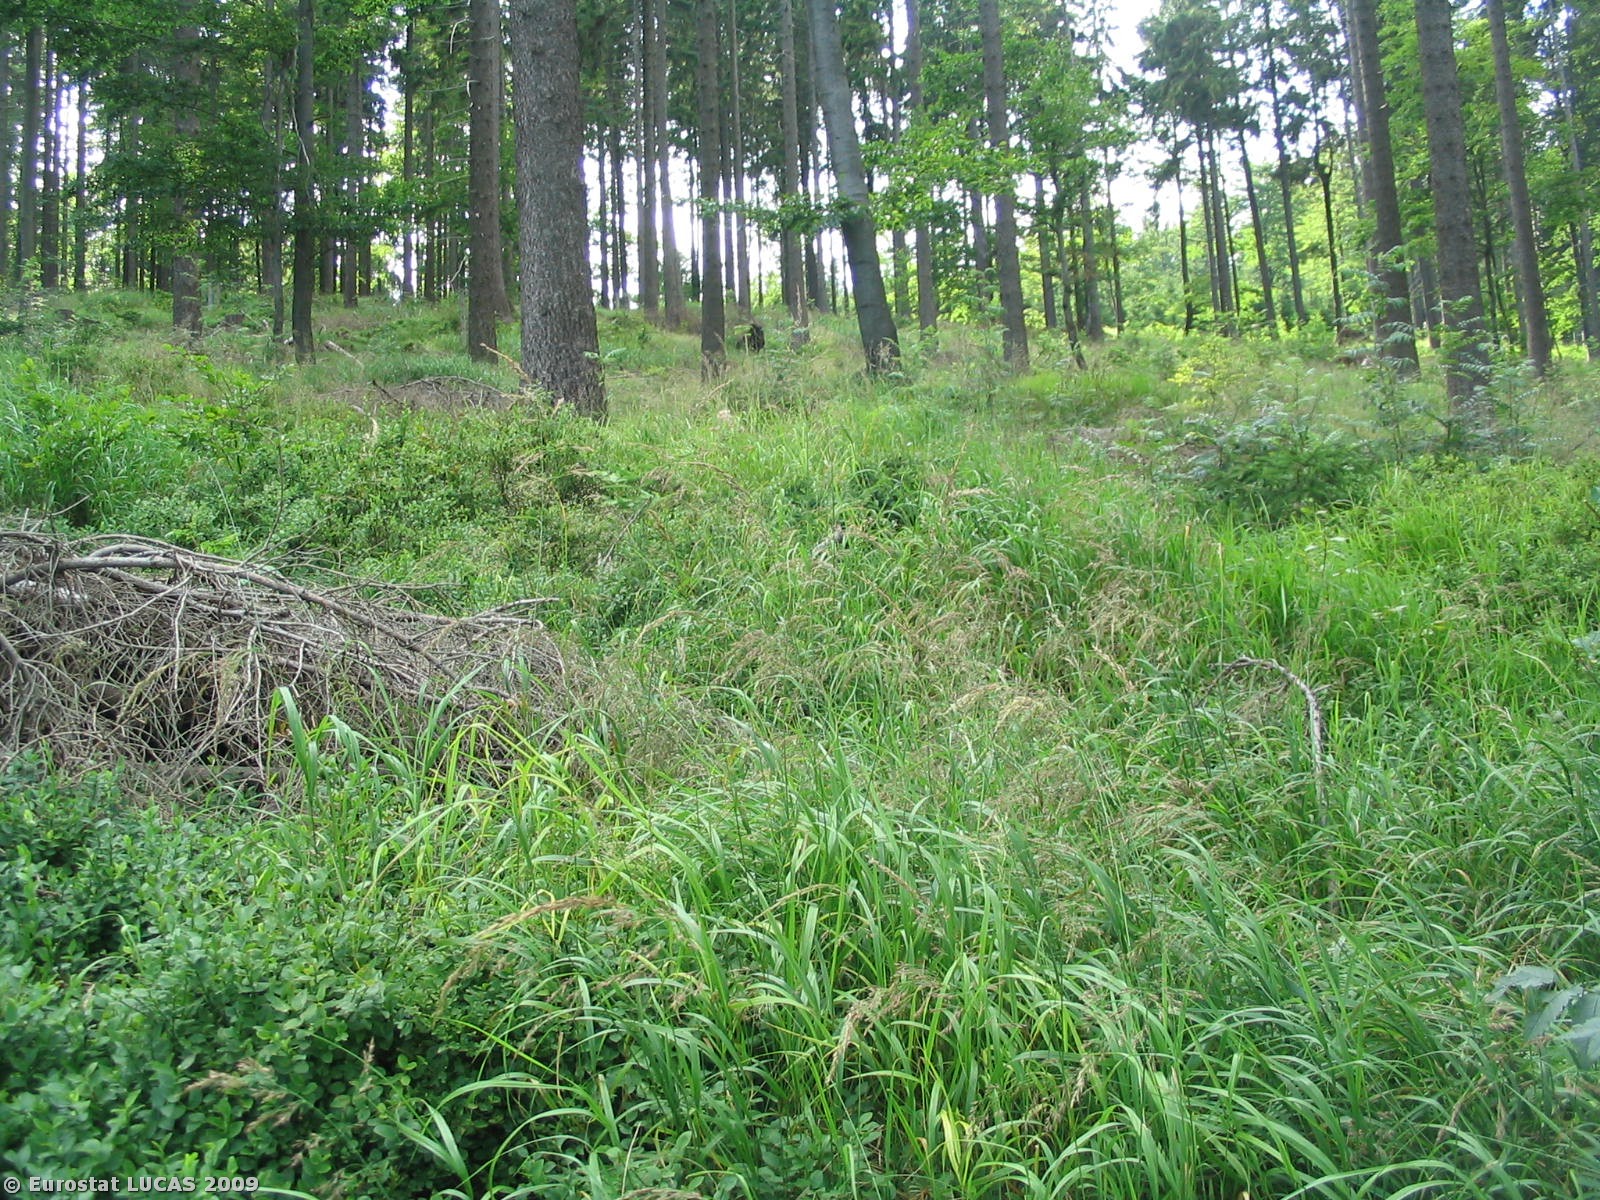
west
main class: Woodland
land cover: Mixed woodland
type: mountainous beech forest
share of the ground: > 75 %
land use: Forestry
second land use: Nature reserves
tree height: > 5 m
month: July
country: CZ
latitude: 50.7177
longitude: 15.5139
